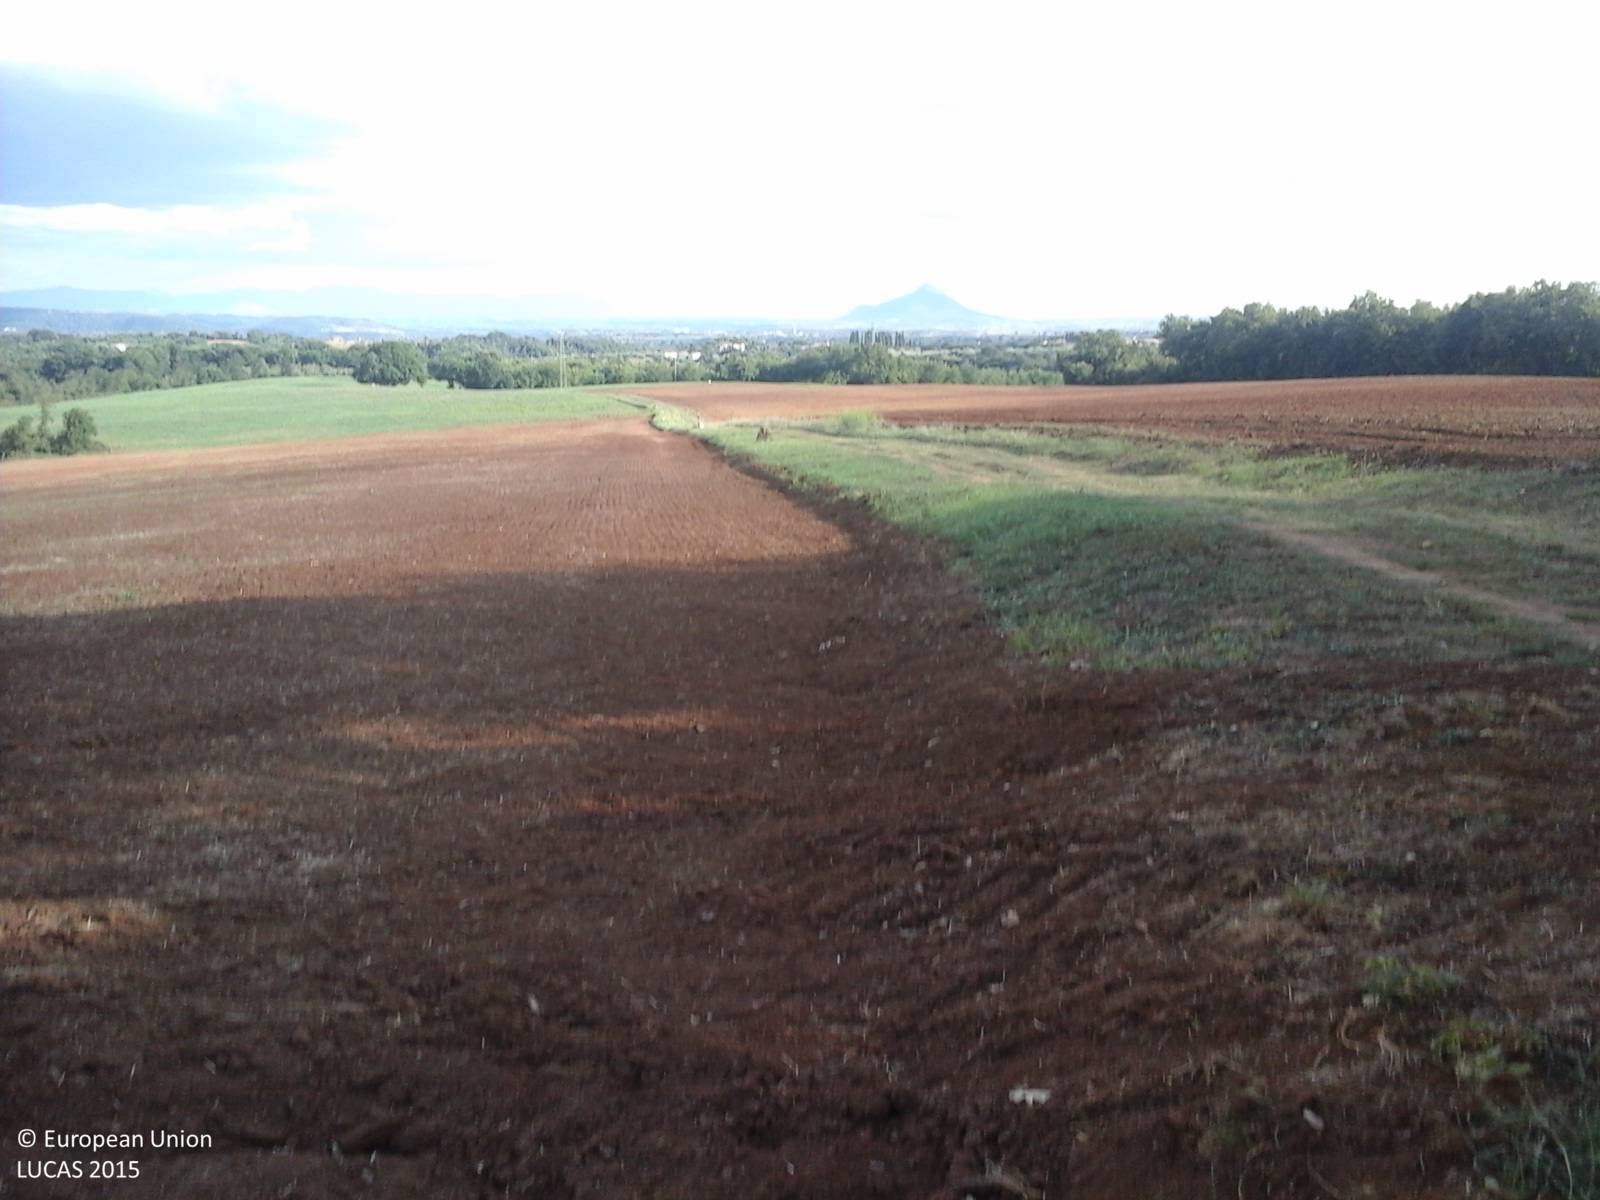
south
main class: Cropland
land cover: Oats
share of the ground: < 10 %
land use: Agriculture (excluding fallow land and kitchen gardens)
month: September
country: IT
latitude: 42.3910
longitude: 12.3850
